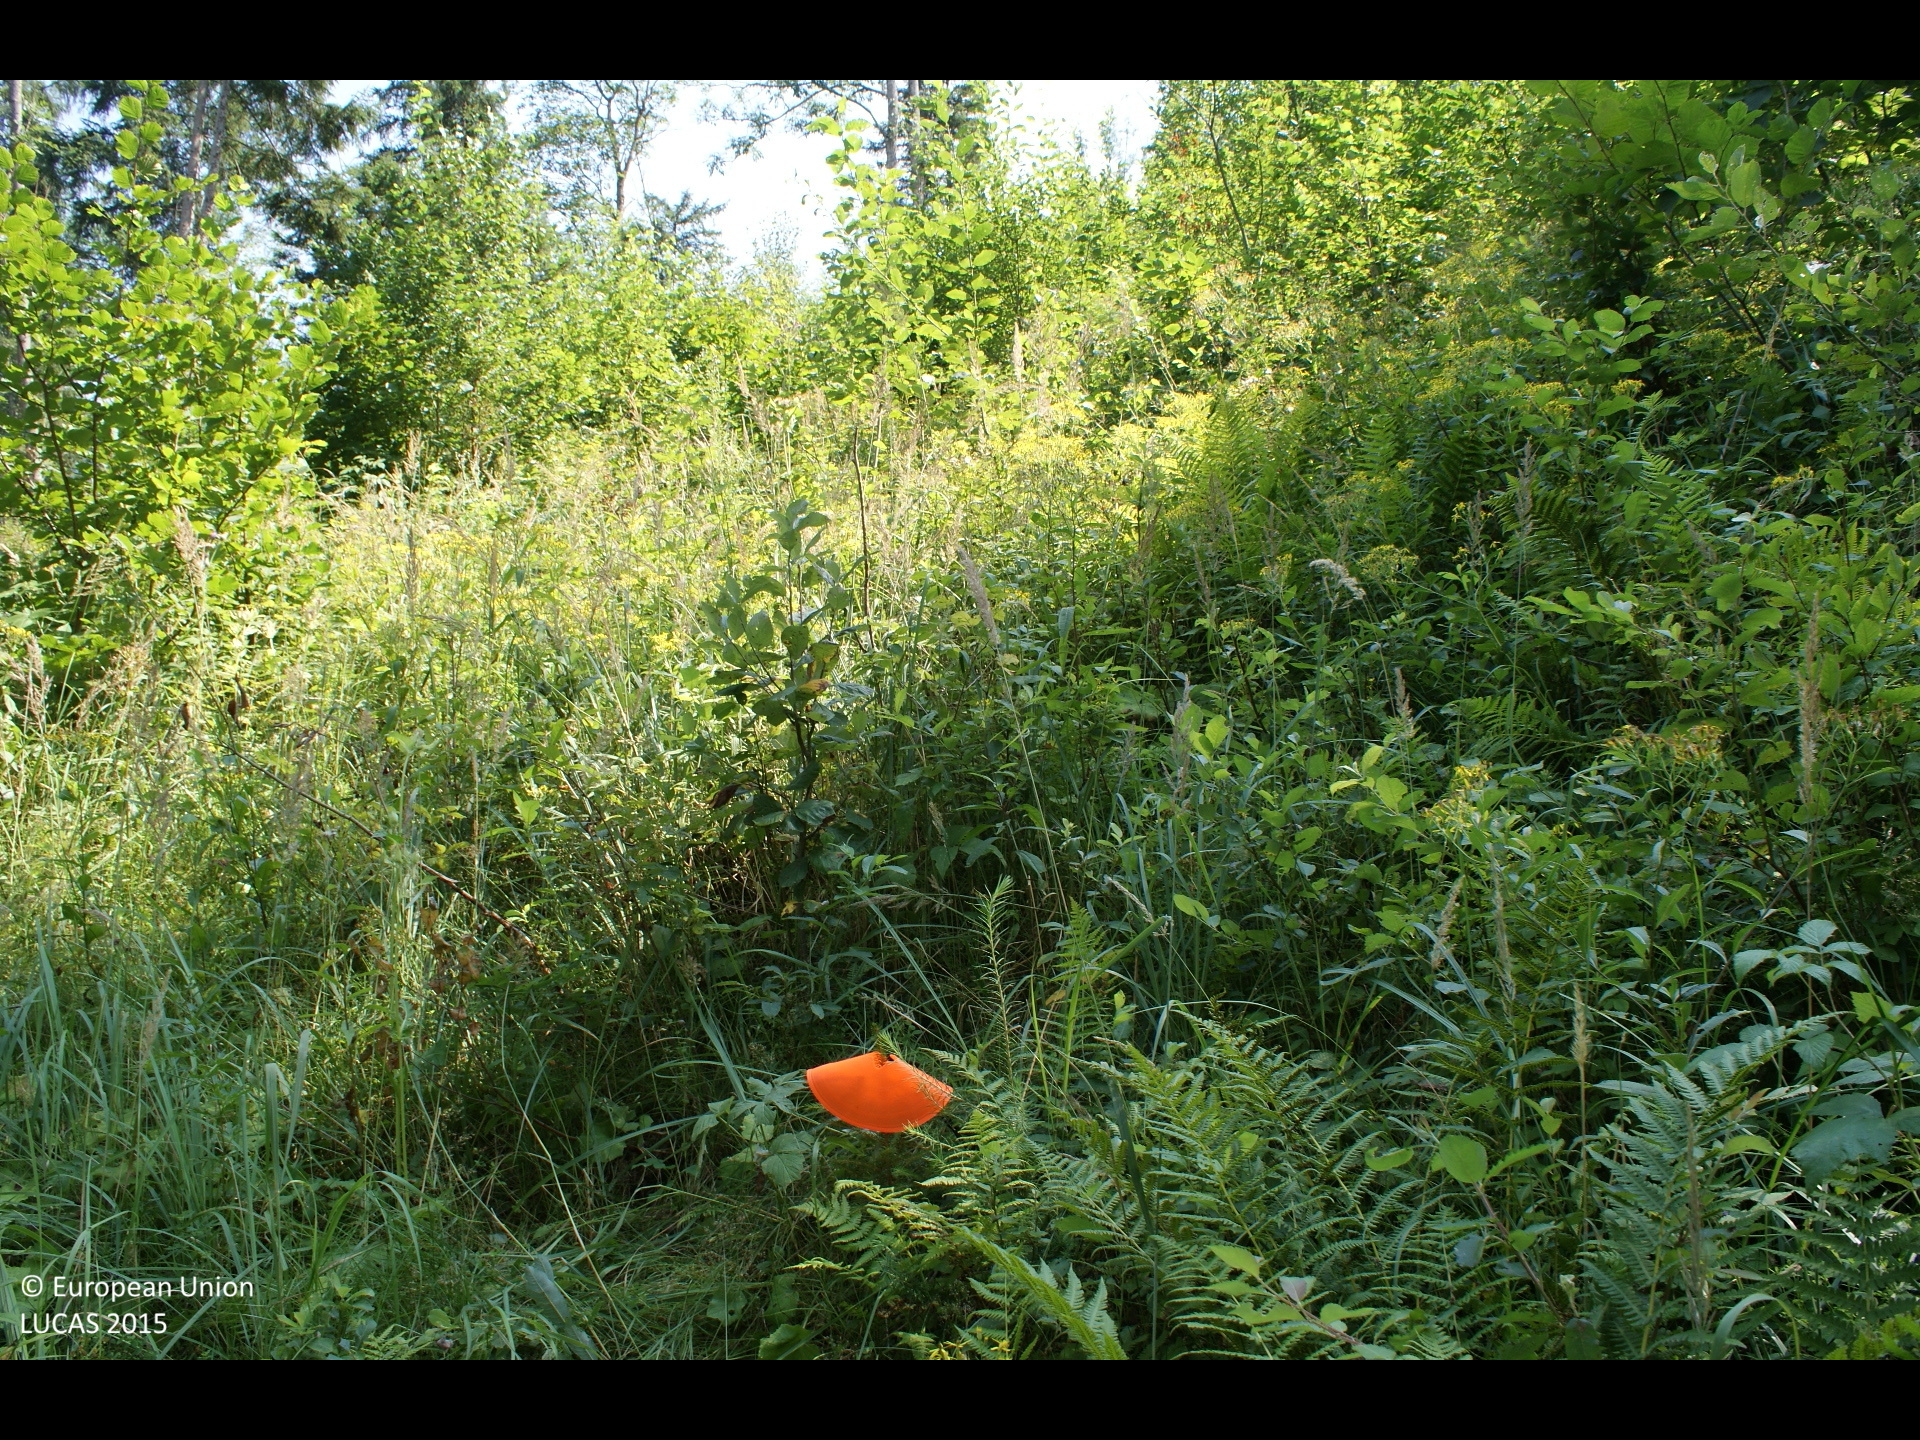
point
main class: Shrubland
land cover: Shrubland with sparse tree cover
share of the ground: > 75 %
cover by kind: shrubs 75 %, herbaceous plants 20 %, broadleaved forest trees 5 %
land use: Forestry
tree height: < 5 m
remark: Clear cut
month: August
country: AT
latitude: 47.7151
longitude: 15.3462
